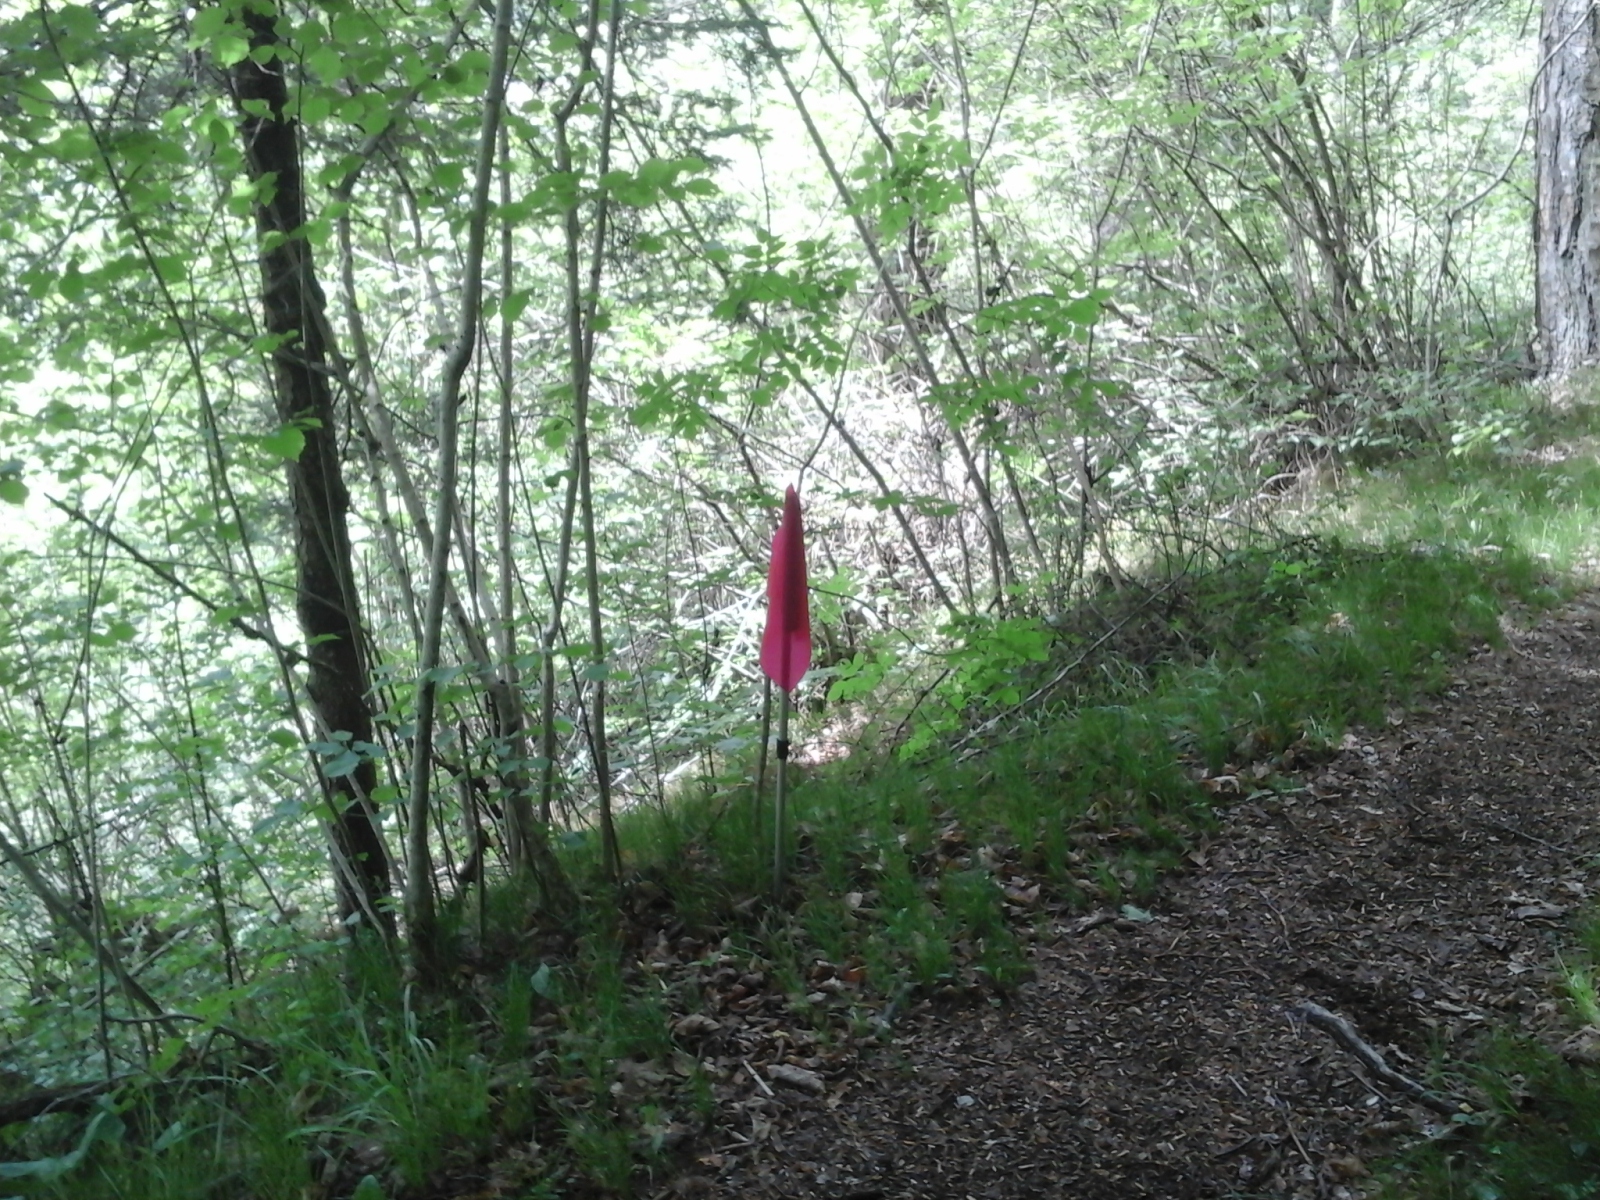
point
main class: Woodland
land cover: Other mixed woodland
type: alpine coniferous forest
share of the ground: > 75 %
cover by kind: broadleaved forest trees 75 %, coniferous forest trees 25 %
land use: Forestry
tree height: > 5 m
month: May
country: IT
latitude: 46.0424
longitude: 10.7355
